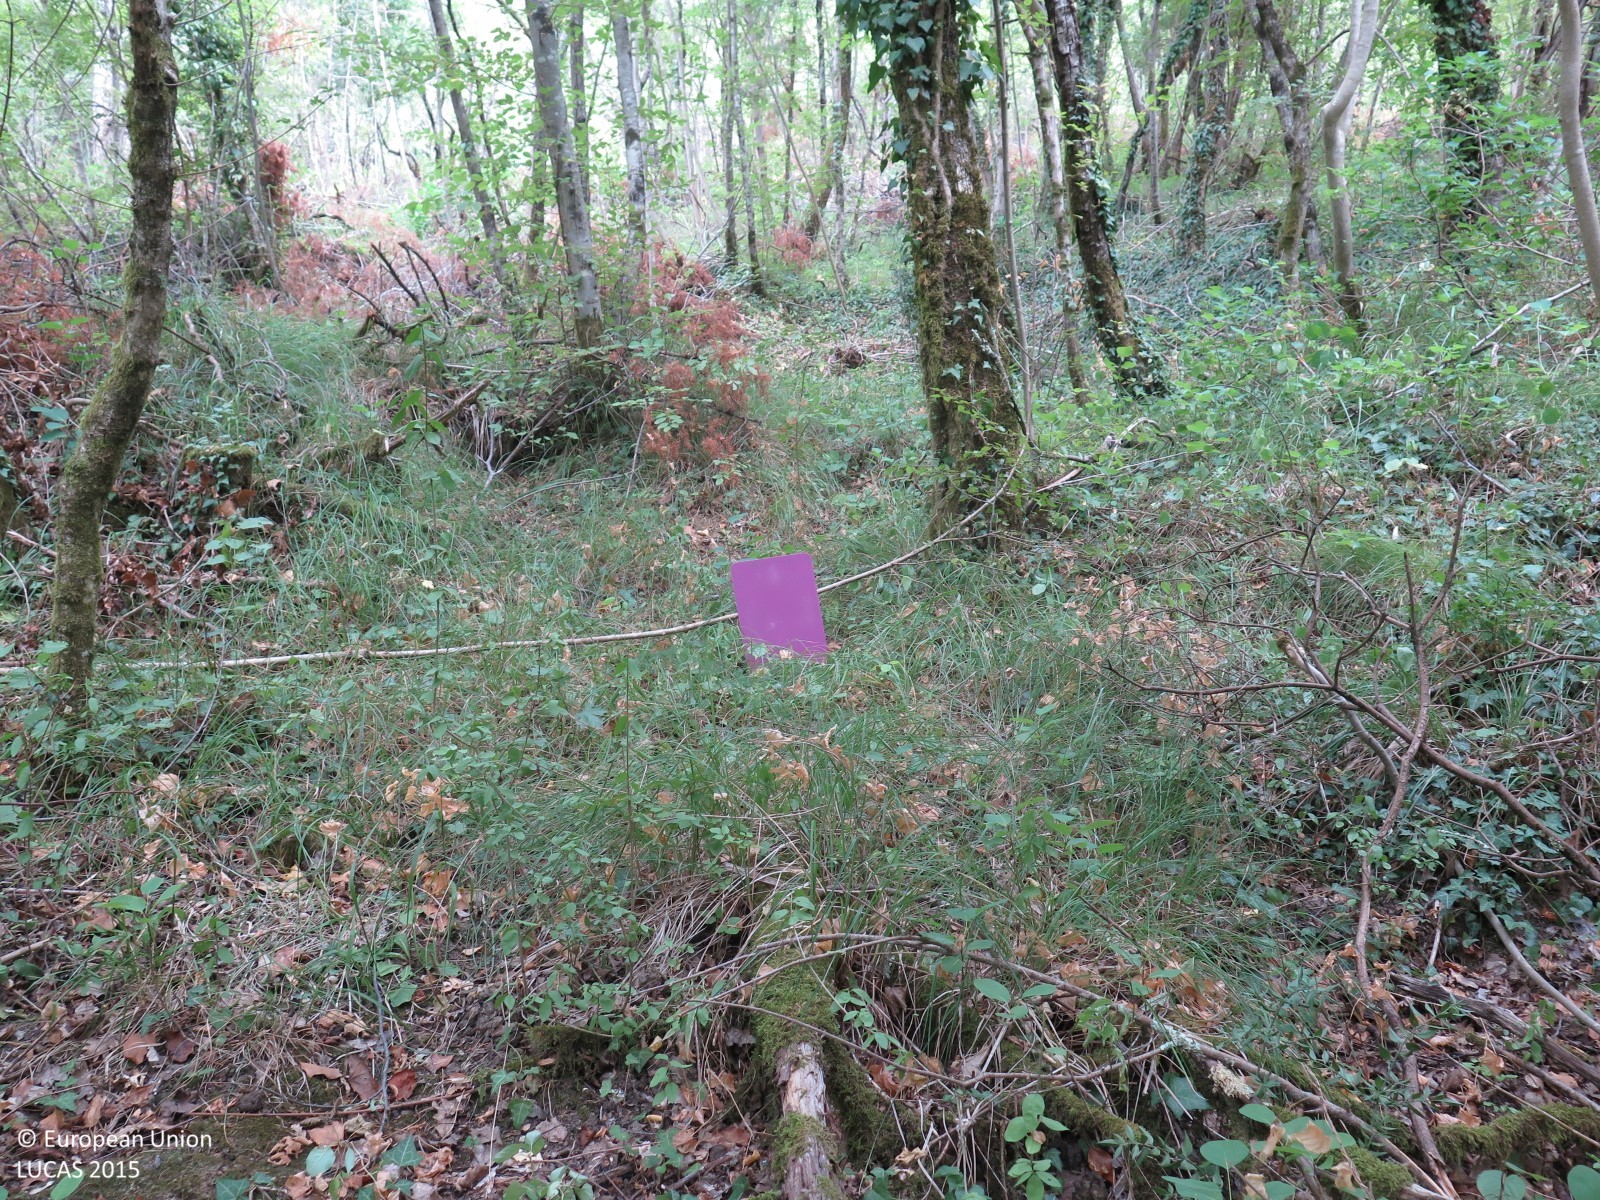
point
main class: Woodland
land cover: Broadleaved woodland
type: beech forest
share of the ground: > 75 %
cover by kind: broadleaved forest trees 95 %, herbaceous plants 5 %
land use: Forestry
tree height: > 5 m
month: July
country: HR
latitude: 45.3160
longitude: 14.1151
